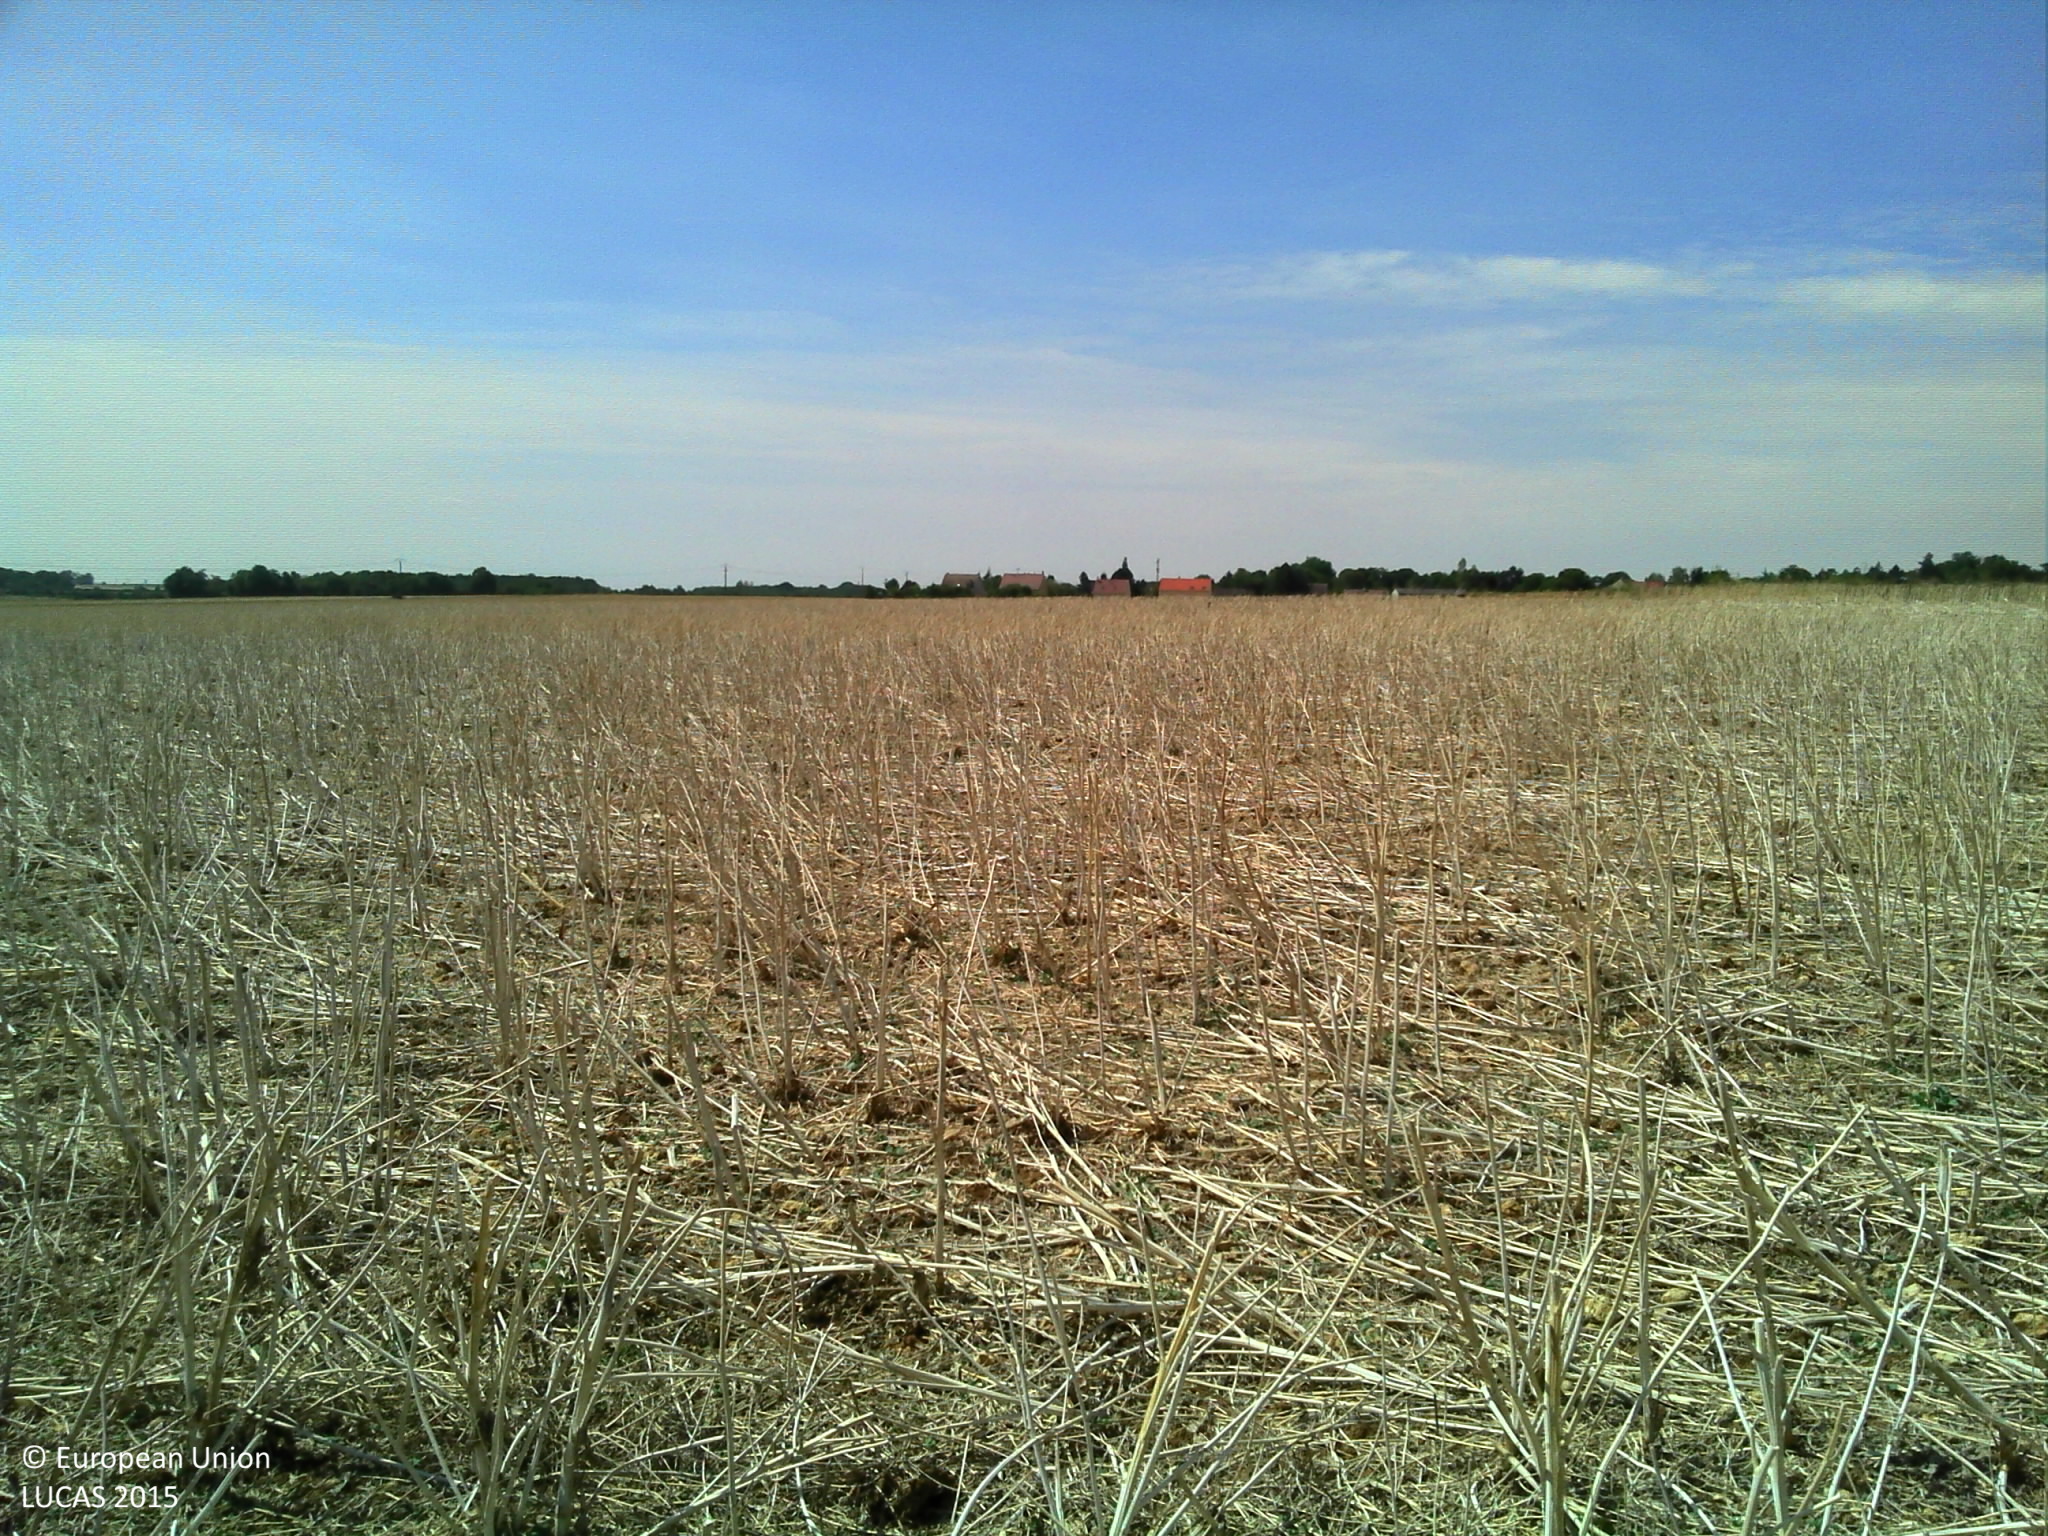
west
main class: Cropland
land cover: Rape and turnip rape
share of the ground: > 75 %
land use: Agriculture (excluding fallow land and kitchen gardens)
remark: Harvested field
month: August
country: FR
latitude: 48.2222
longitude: 2.7901
